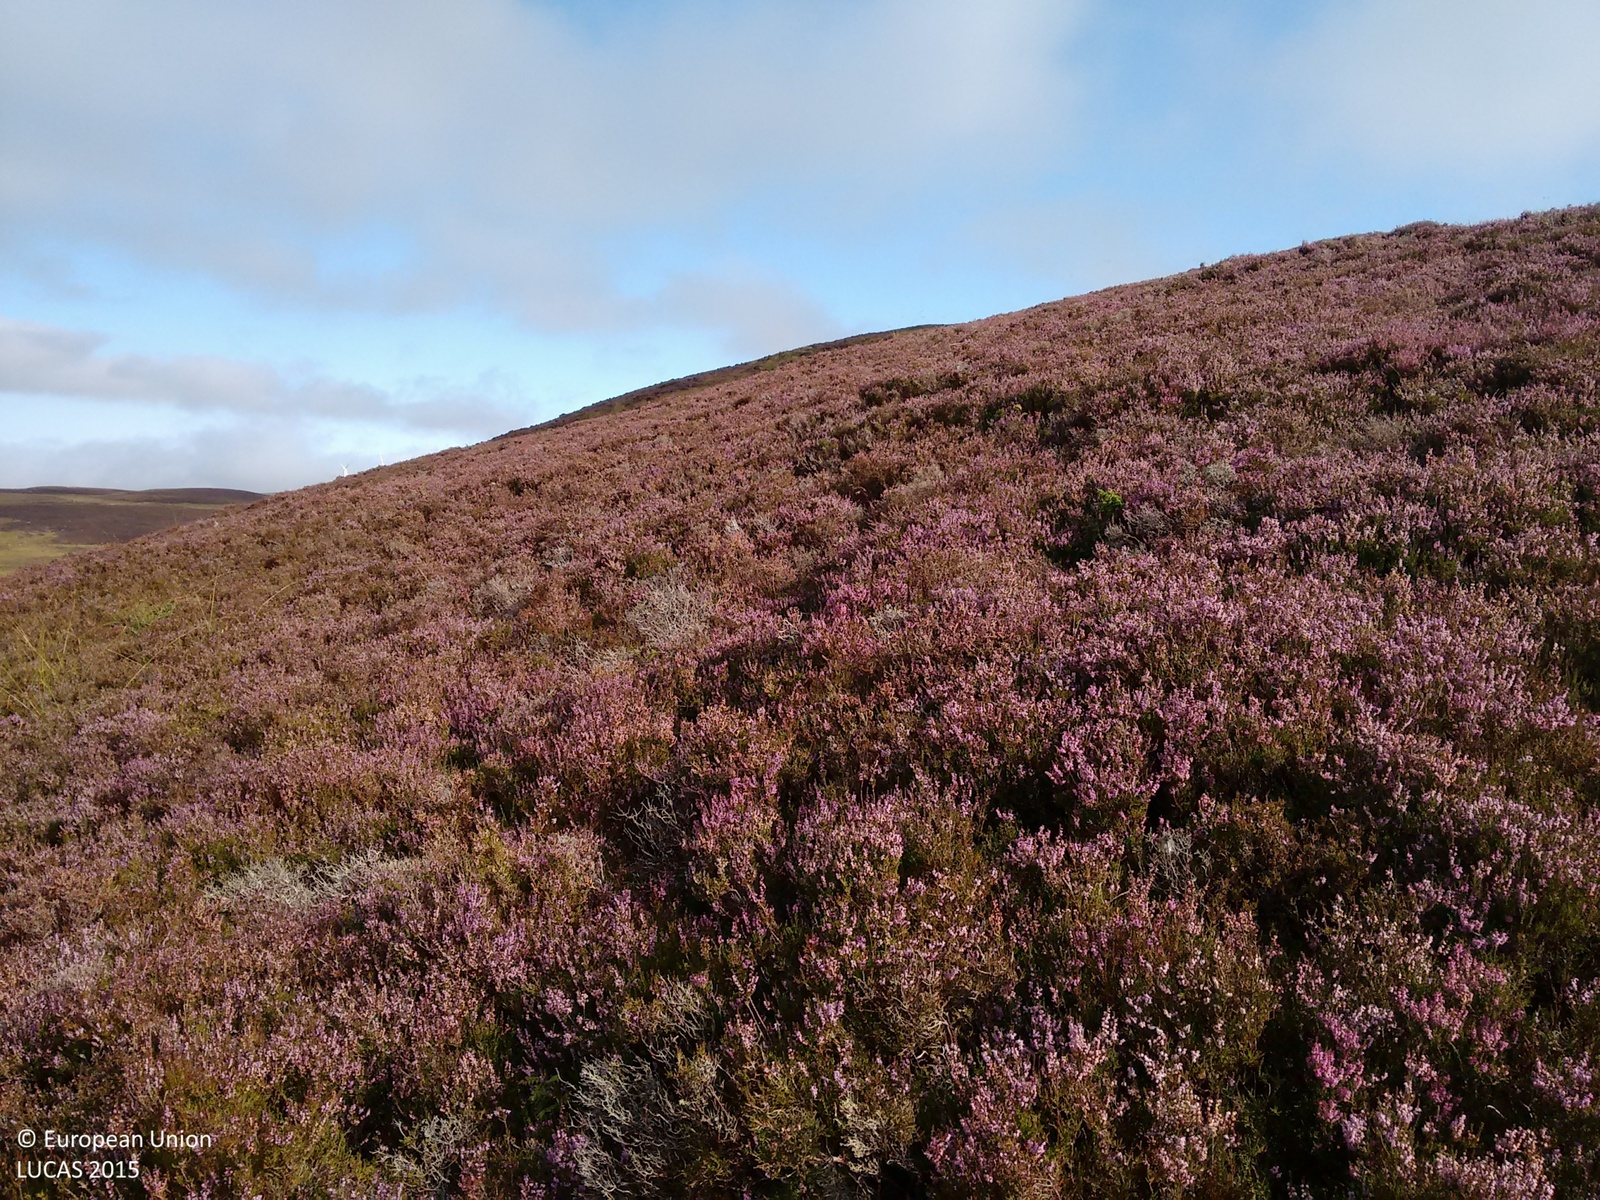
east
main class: Shrubland
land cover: Shrubland without tree cover
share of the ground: > 75 %
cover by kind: shrubs 100 %
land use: Agriculture (excluding fallow land and kitchen gardens)
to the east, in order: Shrubland without tree cover; Fences; Shrubland without tree cover
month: September
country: GB
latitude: 58.0363
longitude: -4.1200
